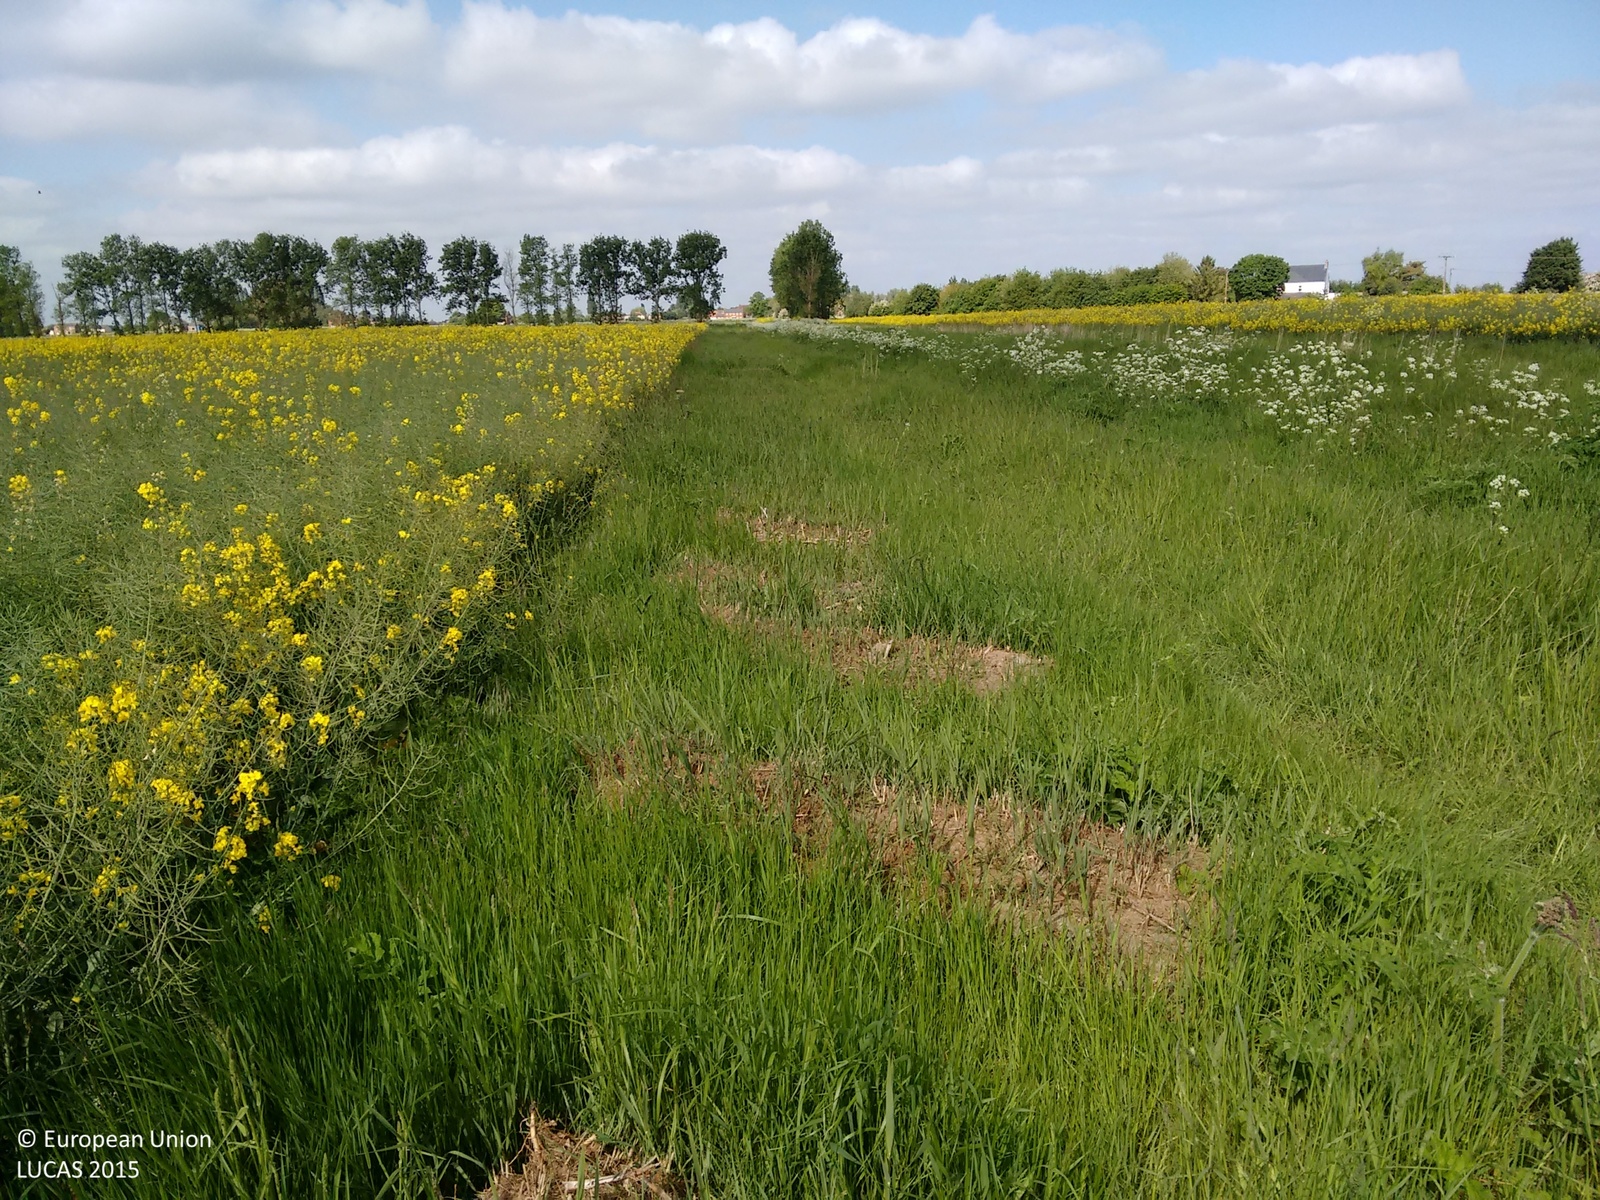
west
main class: Cropland
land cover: Rape and turnip rape
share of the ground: > 75 %
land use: Agriculture (excluding fallow land and kitchen gardens)
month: May
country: GB
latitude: 52.7462
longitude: -0.0620
